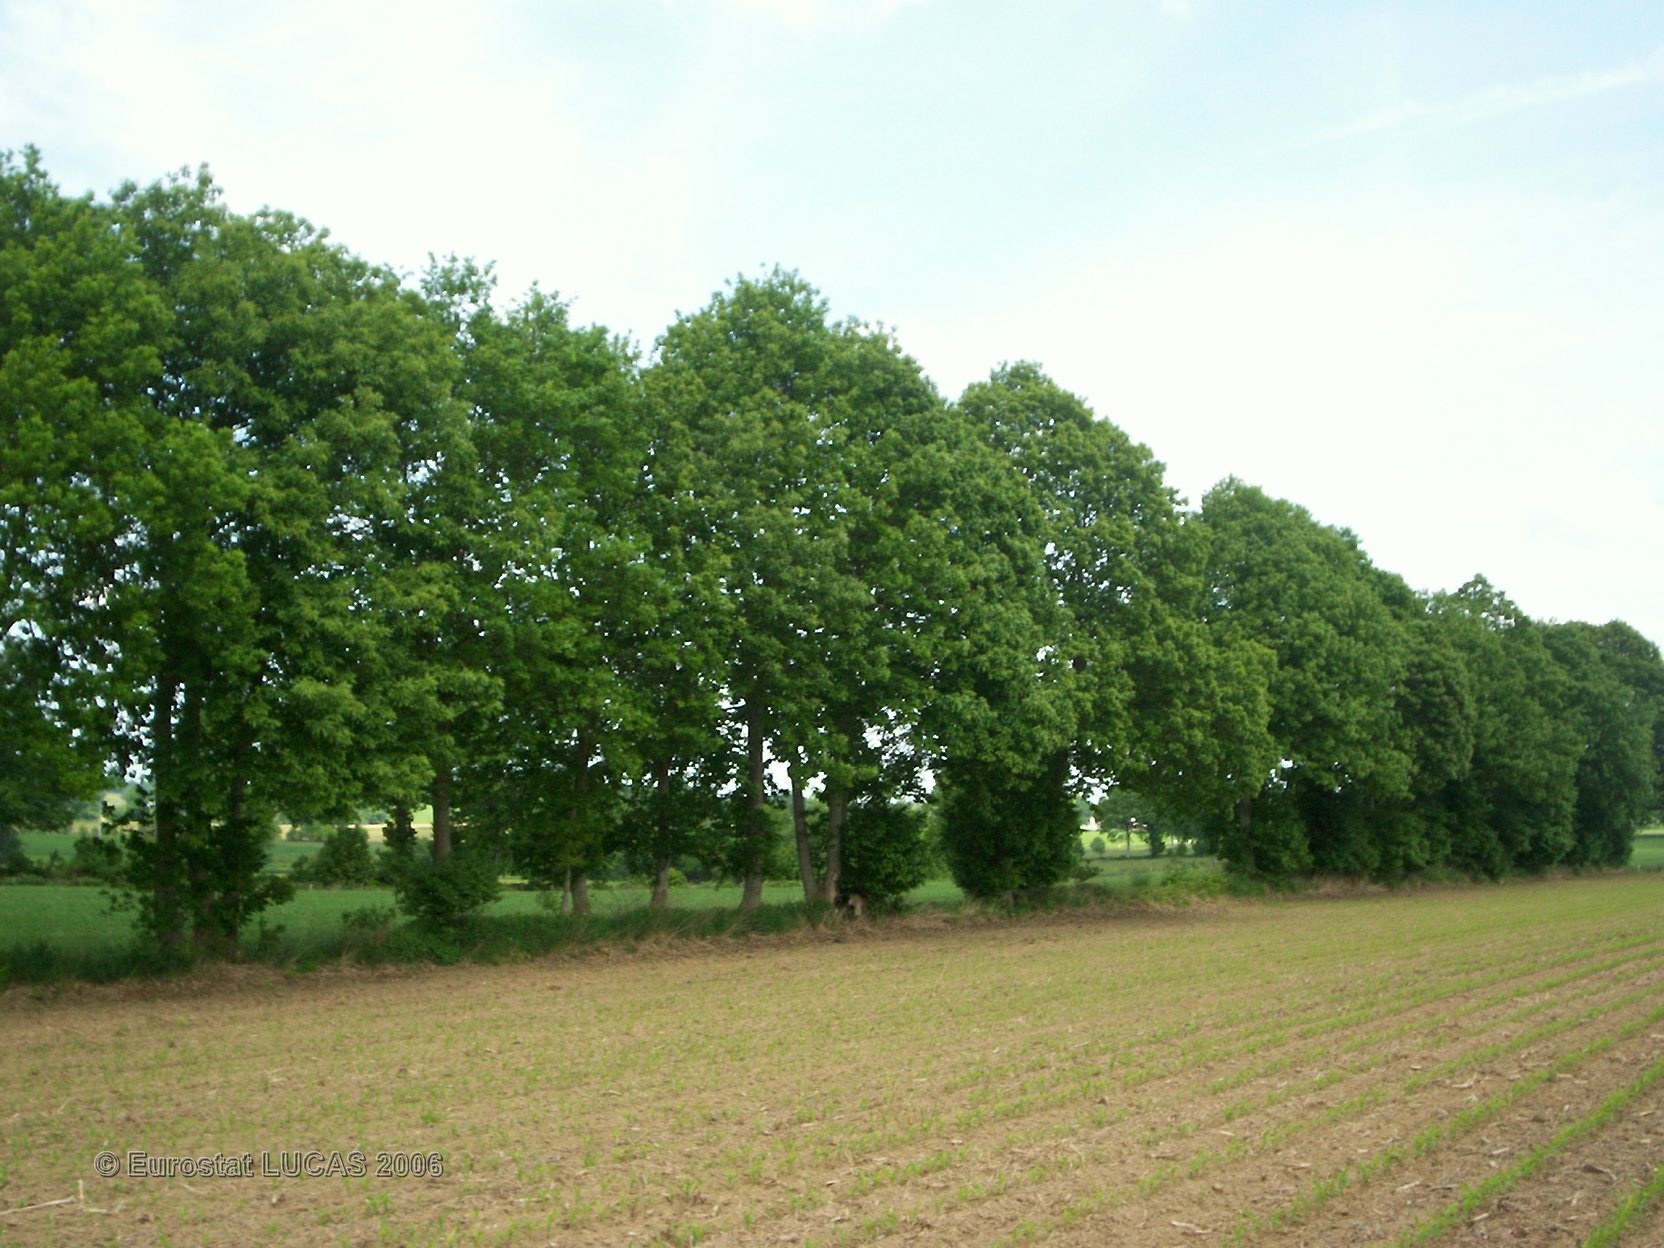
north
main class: Cropland
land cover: Maize
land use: Agriculture (excluding fallow land and kitchen gardens)
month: June
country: FR
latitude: 48.4476
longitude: -1.2241
